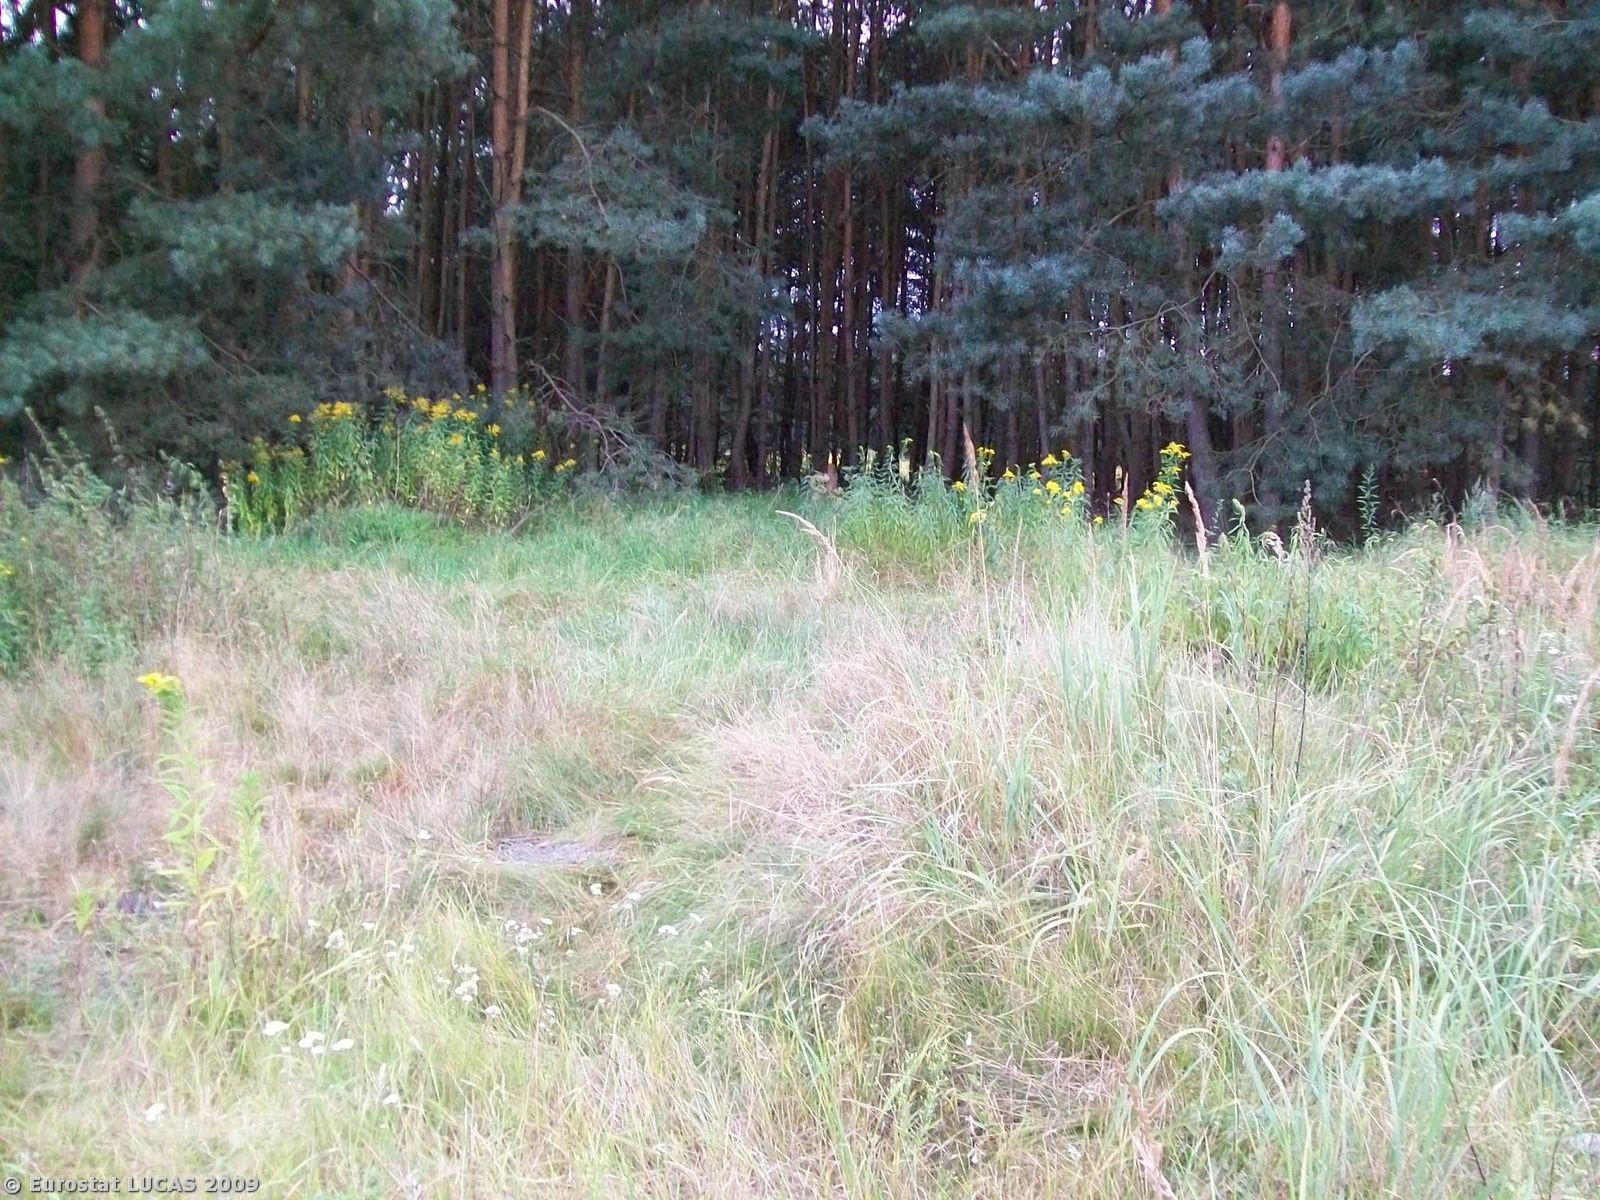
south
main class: Grassland
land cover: Spontaneously vegetated surfaces
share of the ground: > 75 %
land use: Unused
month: August
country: PL
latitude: 50.9388
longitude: 17.9135
